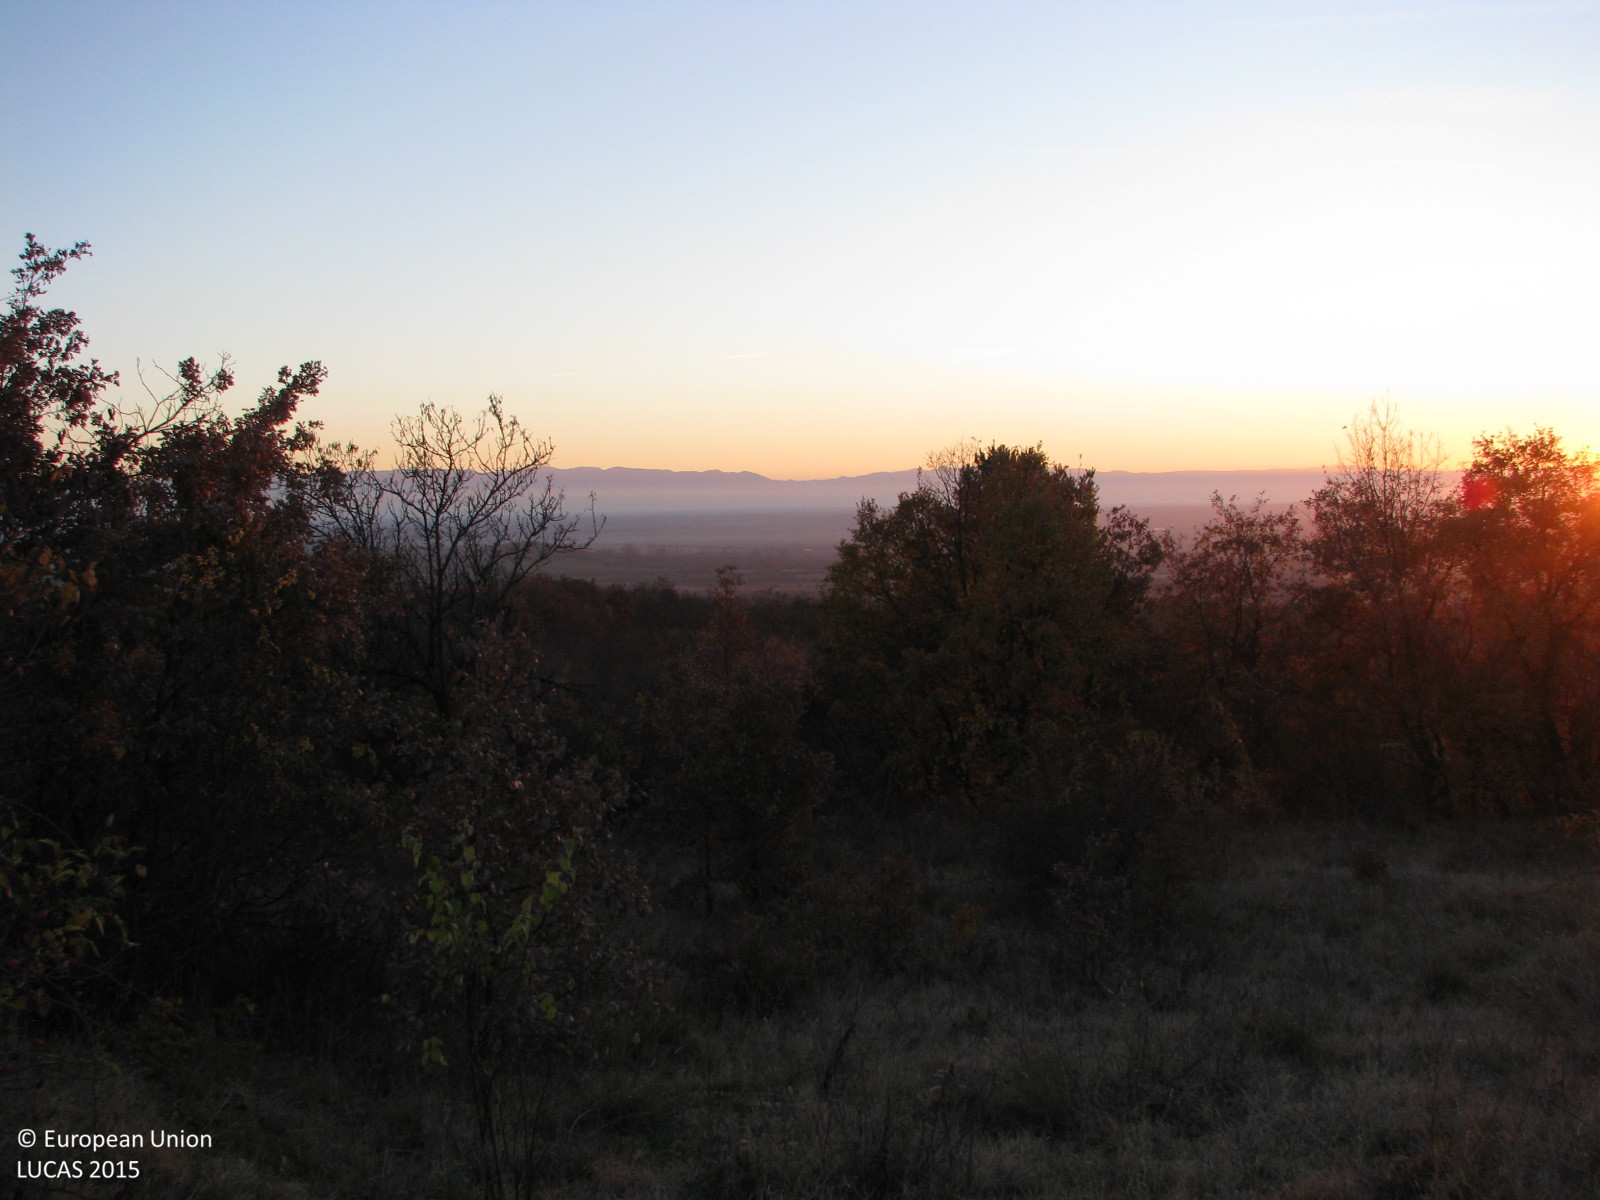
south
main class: Grassland
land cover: Grassland with sparse tree/shrub cover
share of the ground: > 75 %
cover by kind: herbaceous plants 90 %, broadleaved forest trees 5 %, shrubs 5 %
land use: Abandoned areas
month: December
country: BG
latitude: 42.4535
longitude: 24.8303
